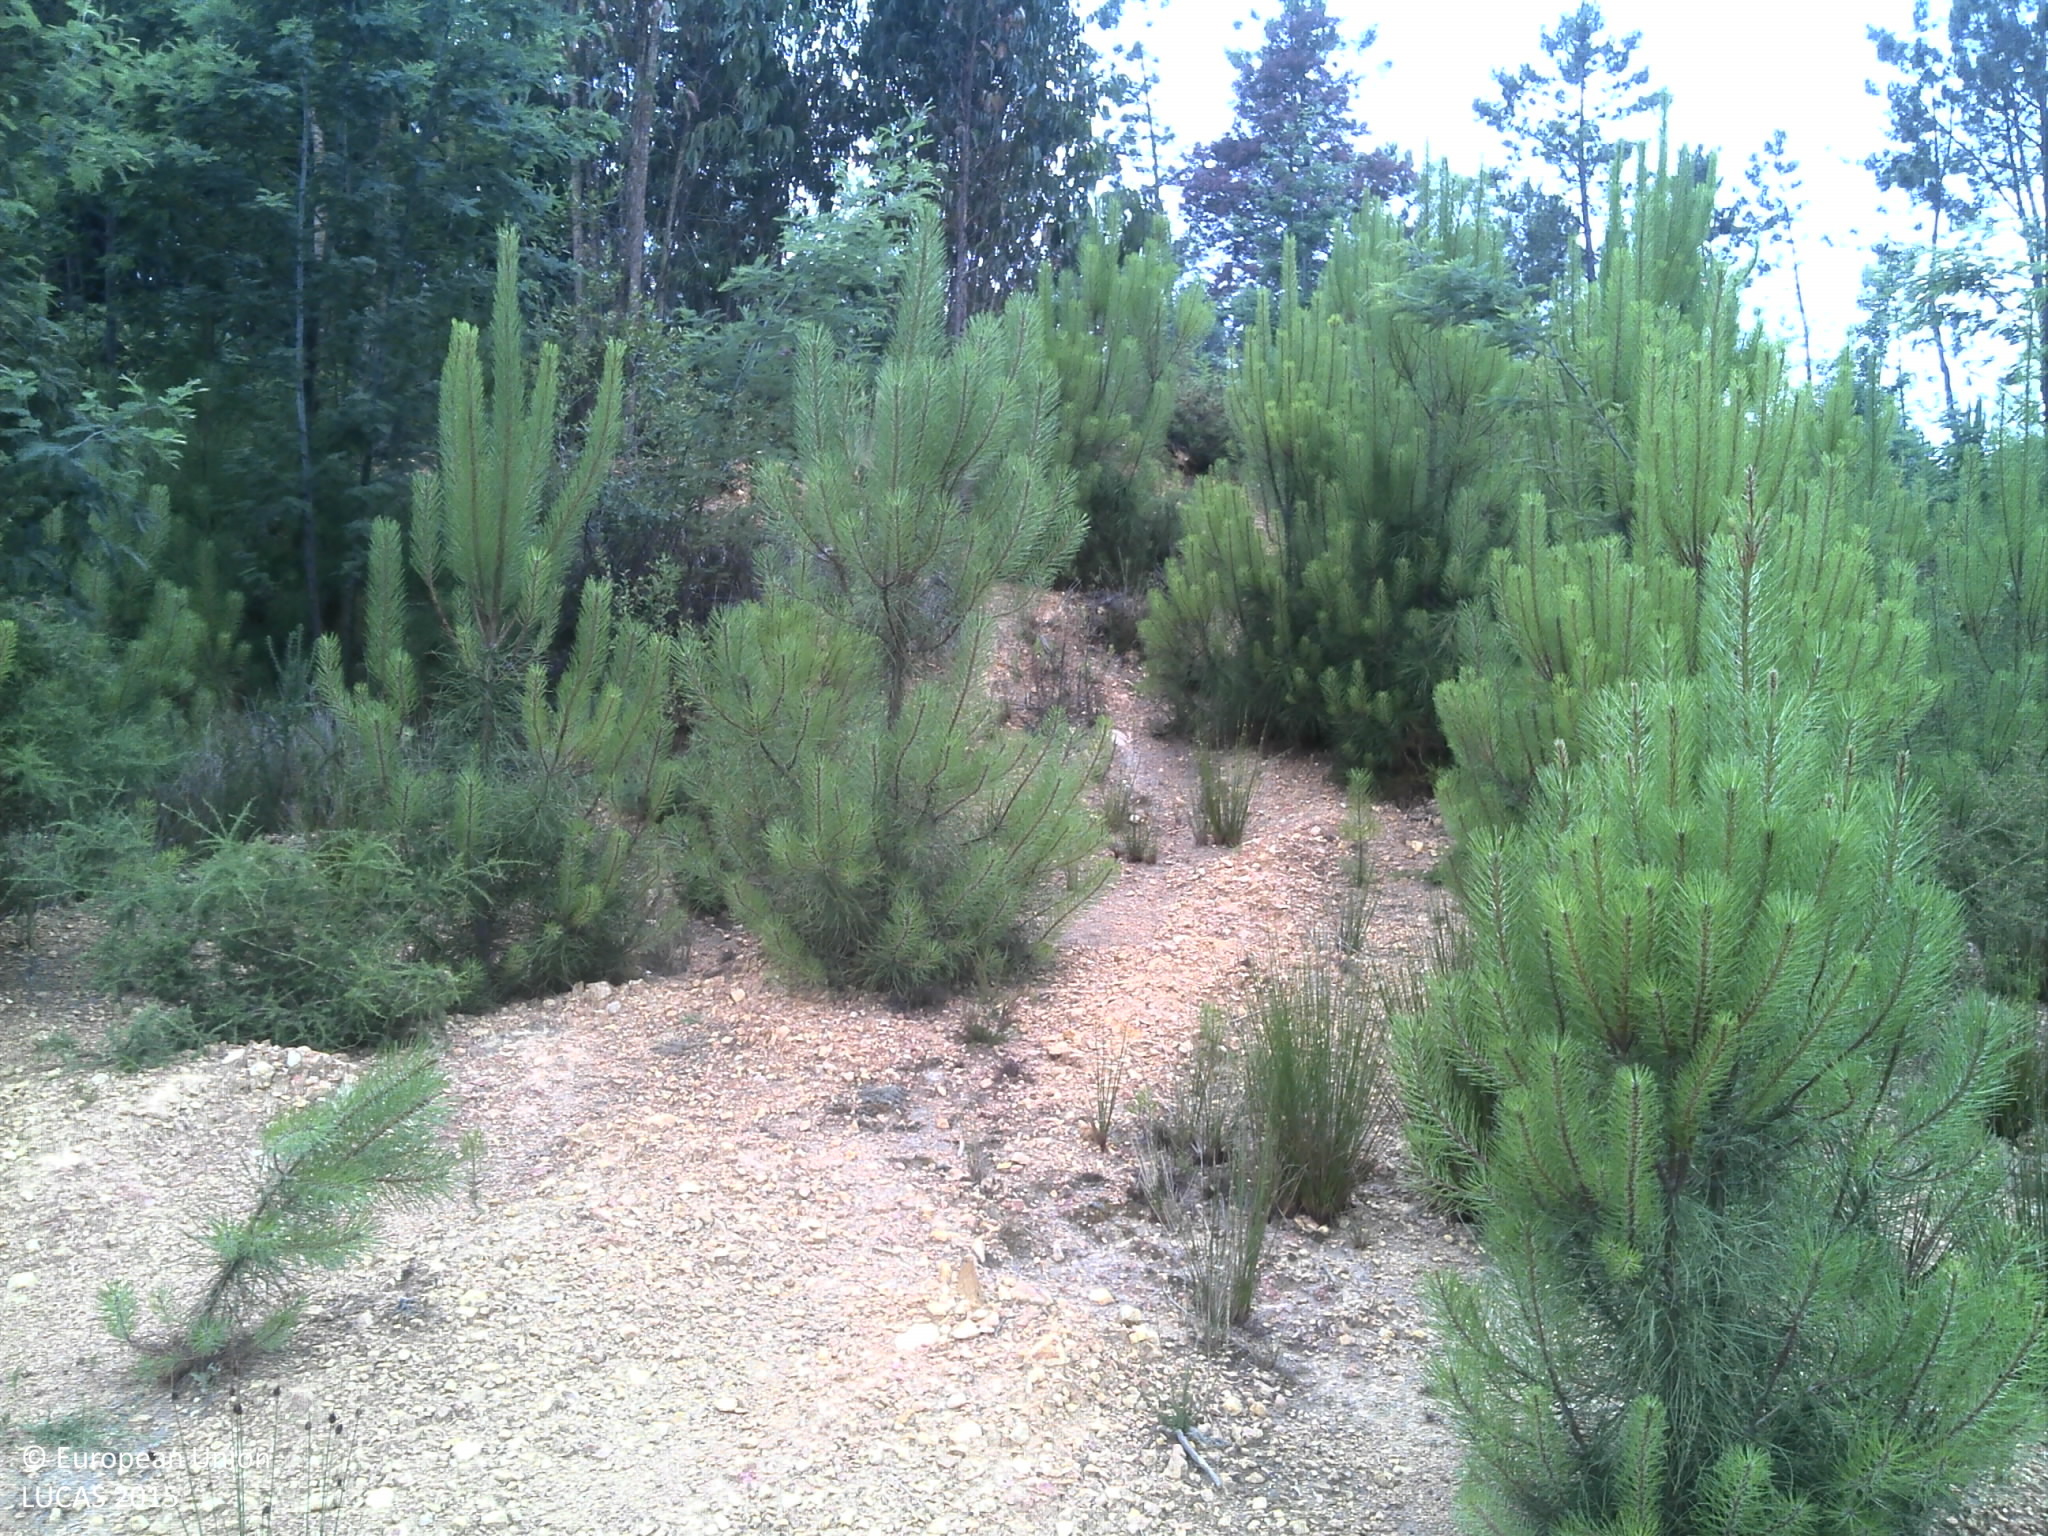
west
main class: Woodland
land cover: Pine dominated coniferous woodland
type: coniferous forest of the mediterranean region
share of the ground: 50 - 75 %
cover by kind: coniferous forest trees 50 %, unconsolidated bare surface 30 %, shrubs 20 %
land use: Semi-natural and natural areas not in use
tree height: < 5 m
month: June
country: PT
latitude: 40.5046
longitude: -8.4146
